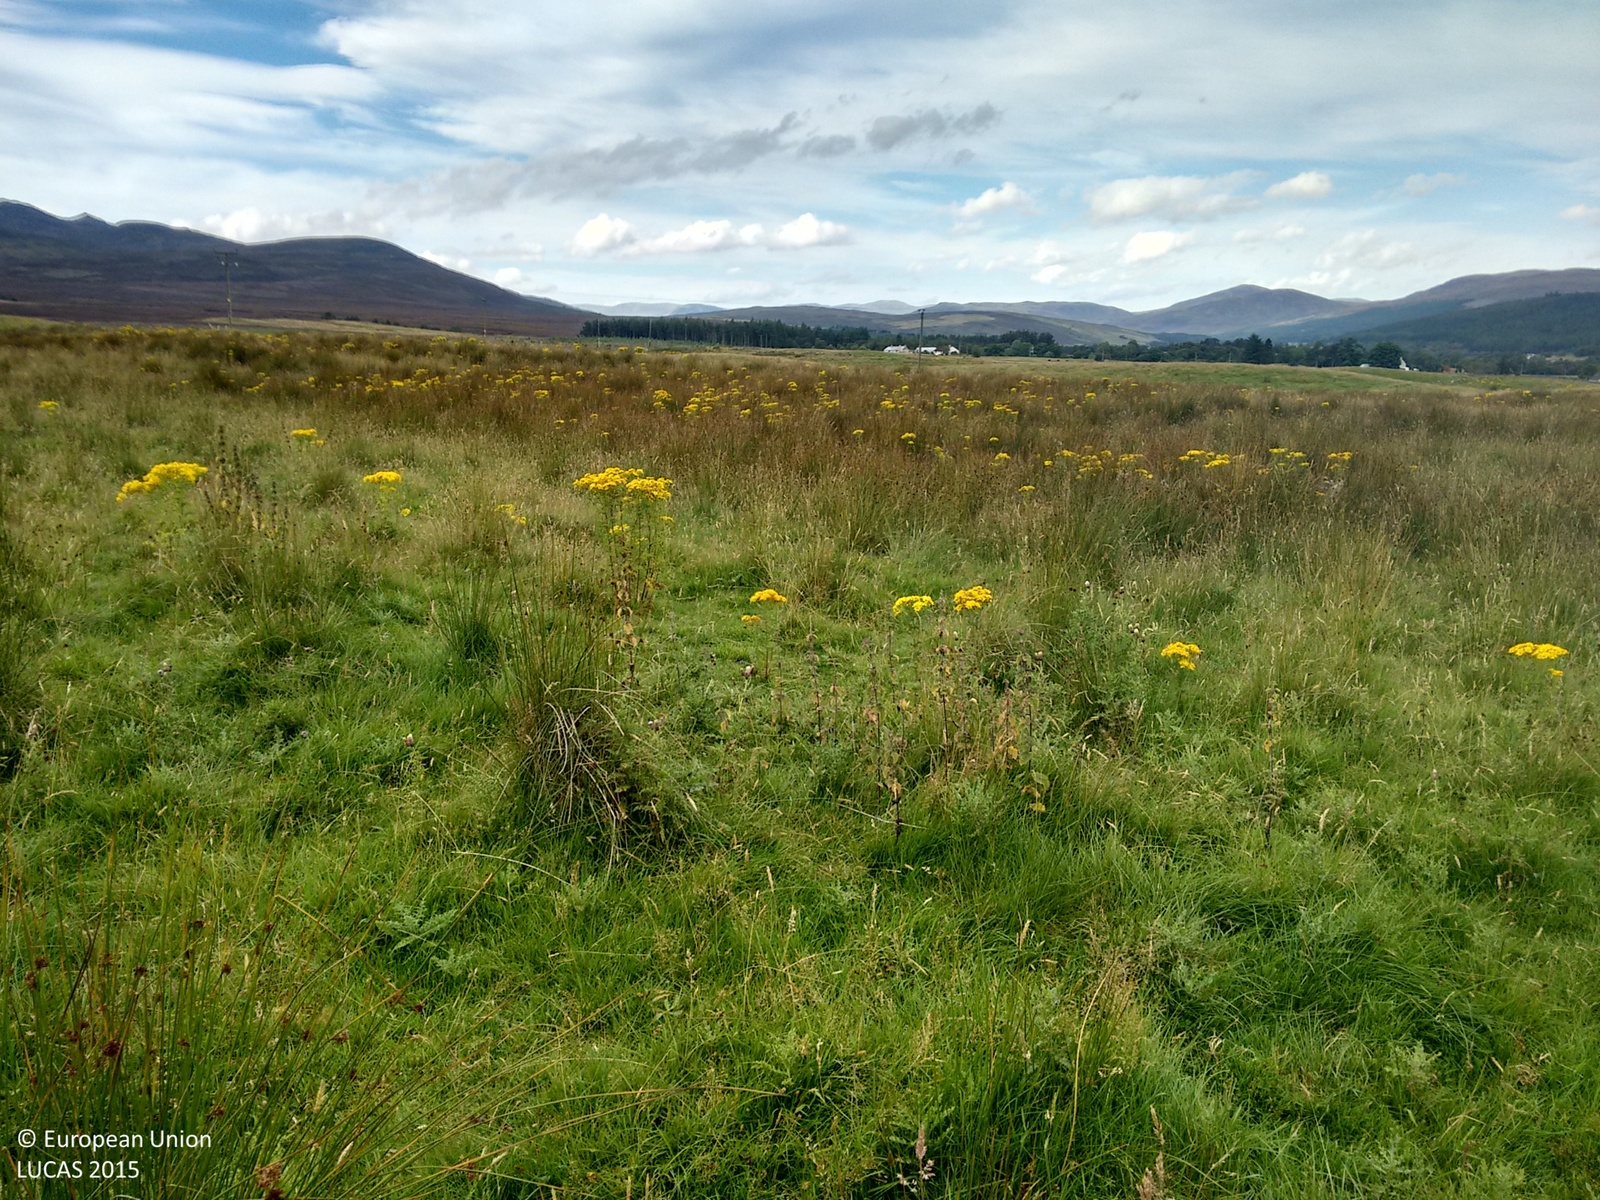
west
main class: Grassland
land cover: Grassland without tree/shrub cover
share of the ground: > 75 %
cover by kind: herbaceous plants 100 %
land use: Agriculture (excluding fallow land and kitchen gardens)
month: September
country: GB
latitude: 57.8776
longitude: -4.4024
